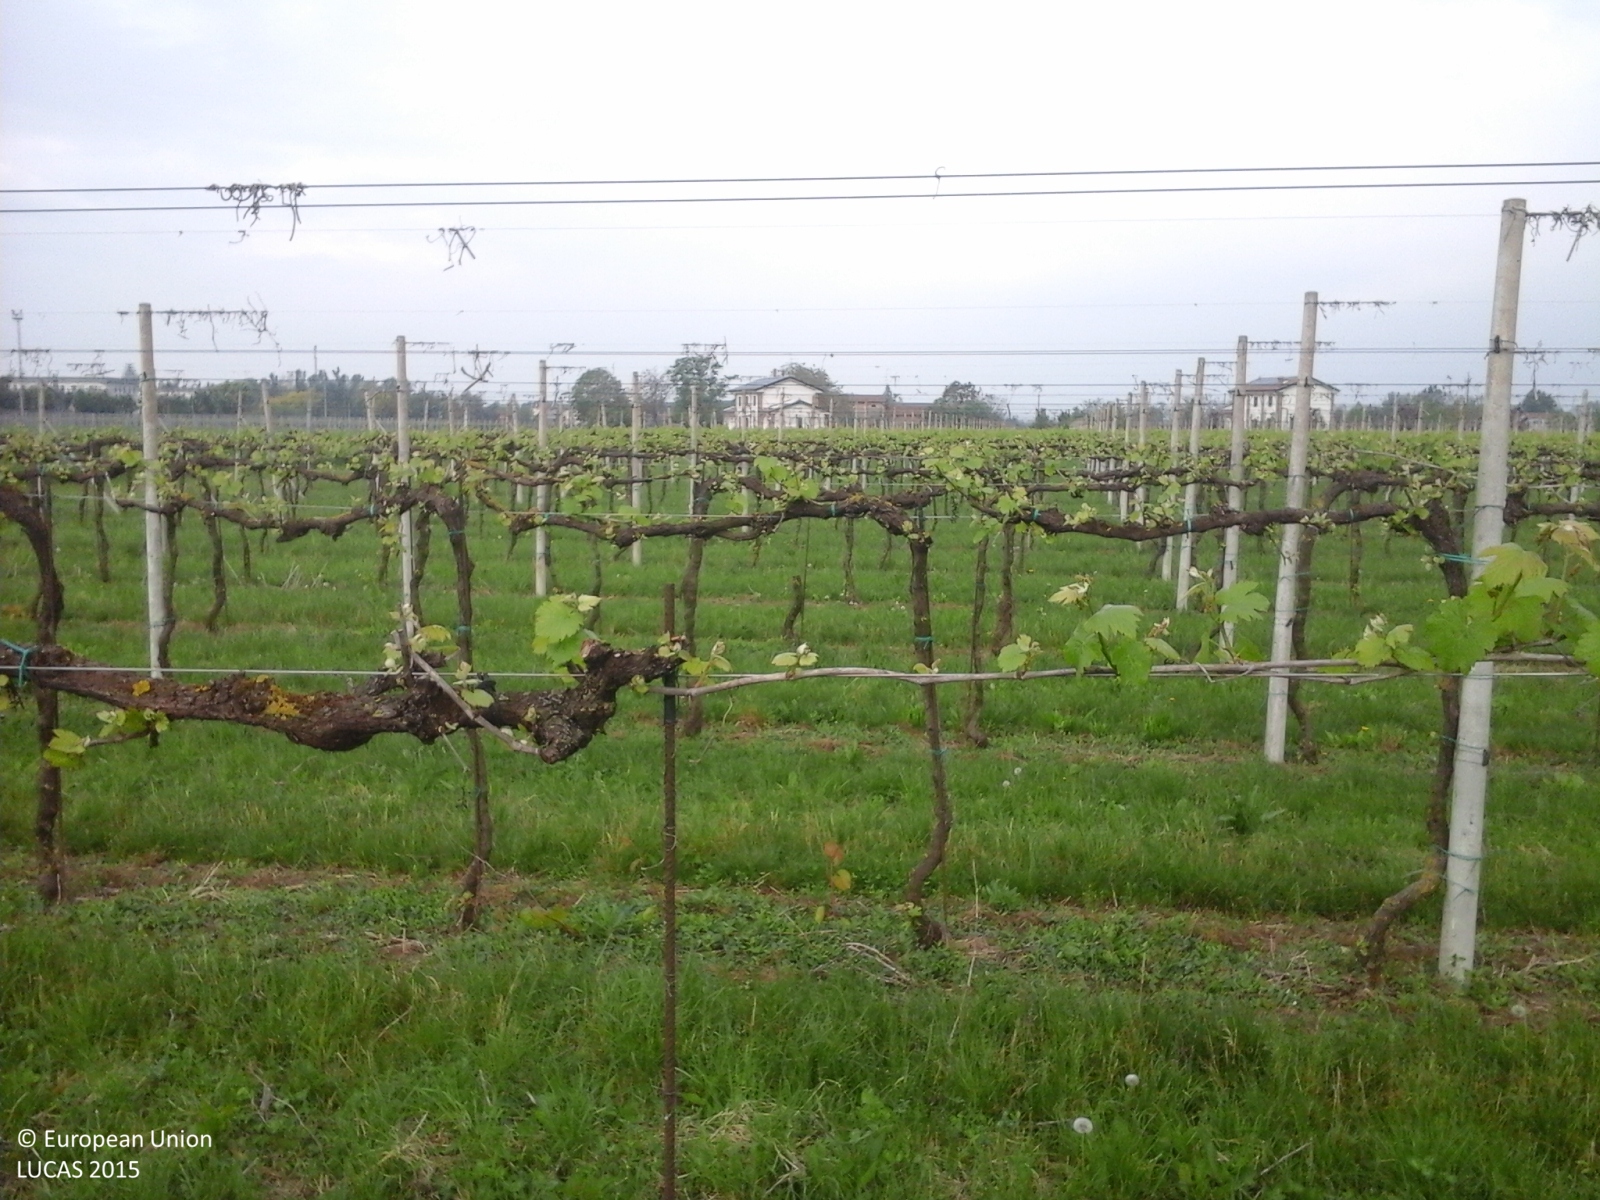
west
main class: Cropland
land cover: Vineyards
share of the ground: 10 - 25 %
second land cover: Grassland without tree/shrub cover
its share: > 75 %
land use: Agriculture (excluding fallow land and kitchen gardens)
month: April
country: IT
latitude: 44.8879
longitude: 10.8719
